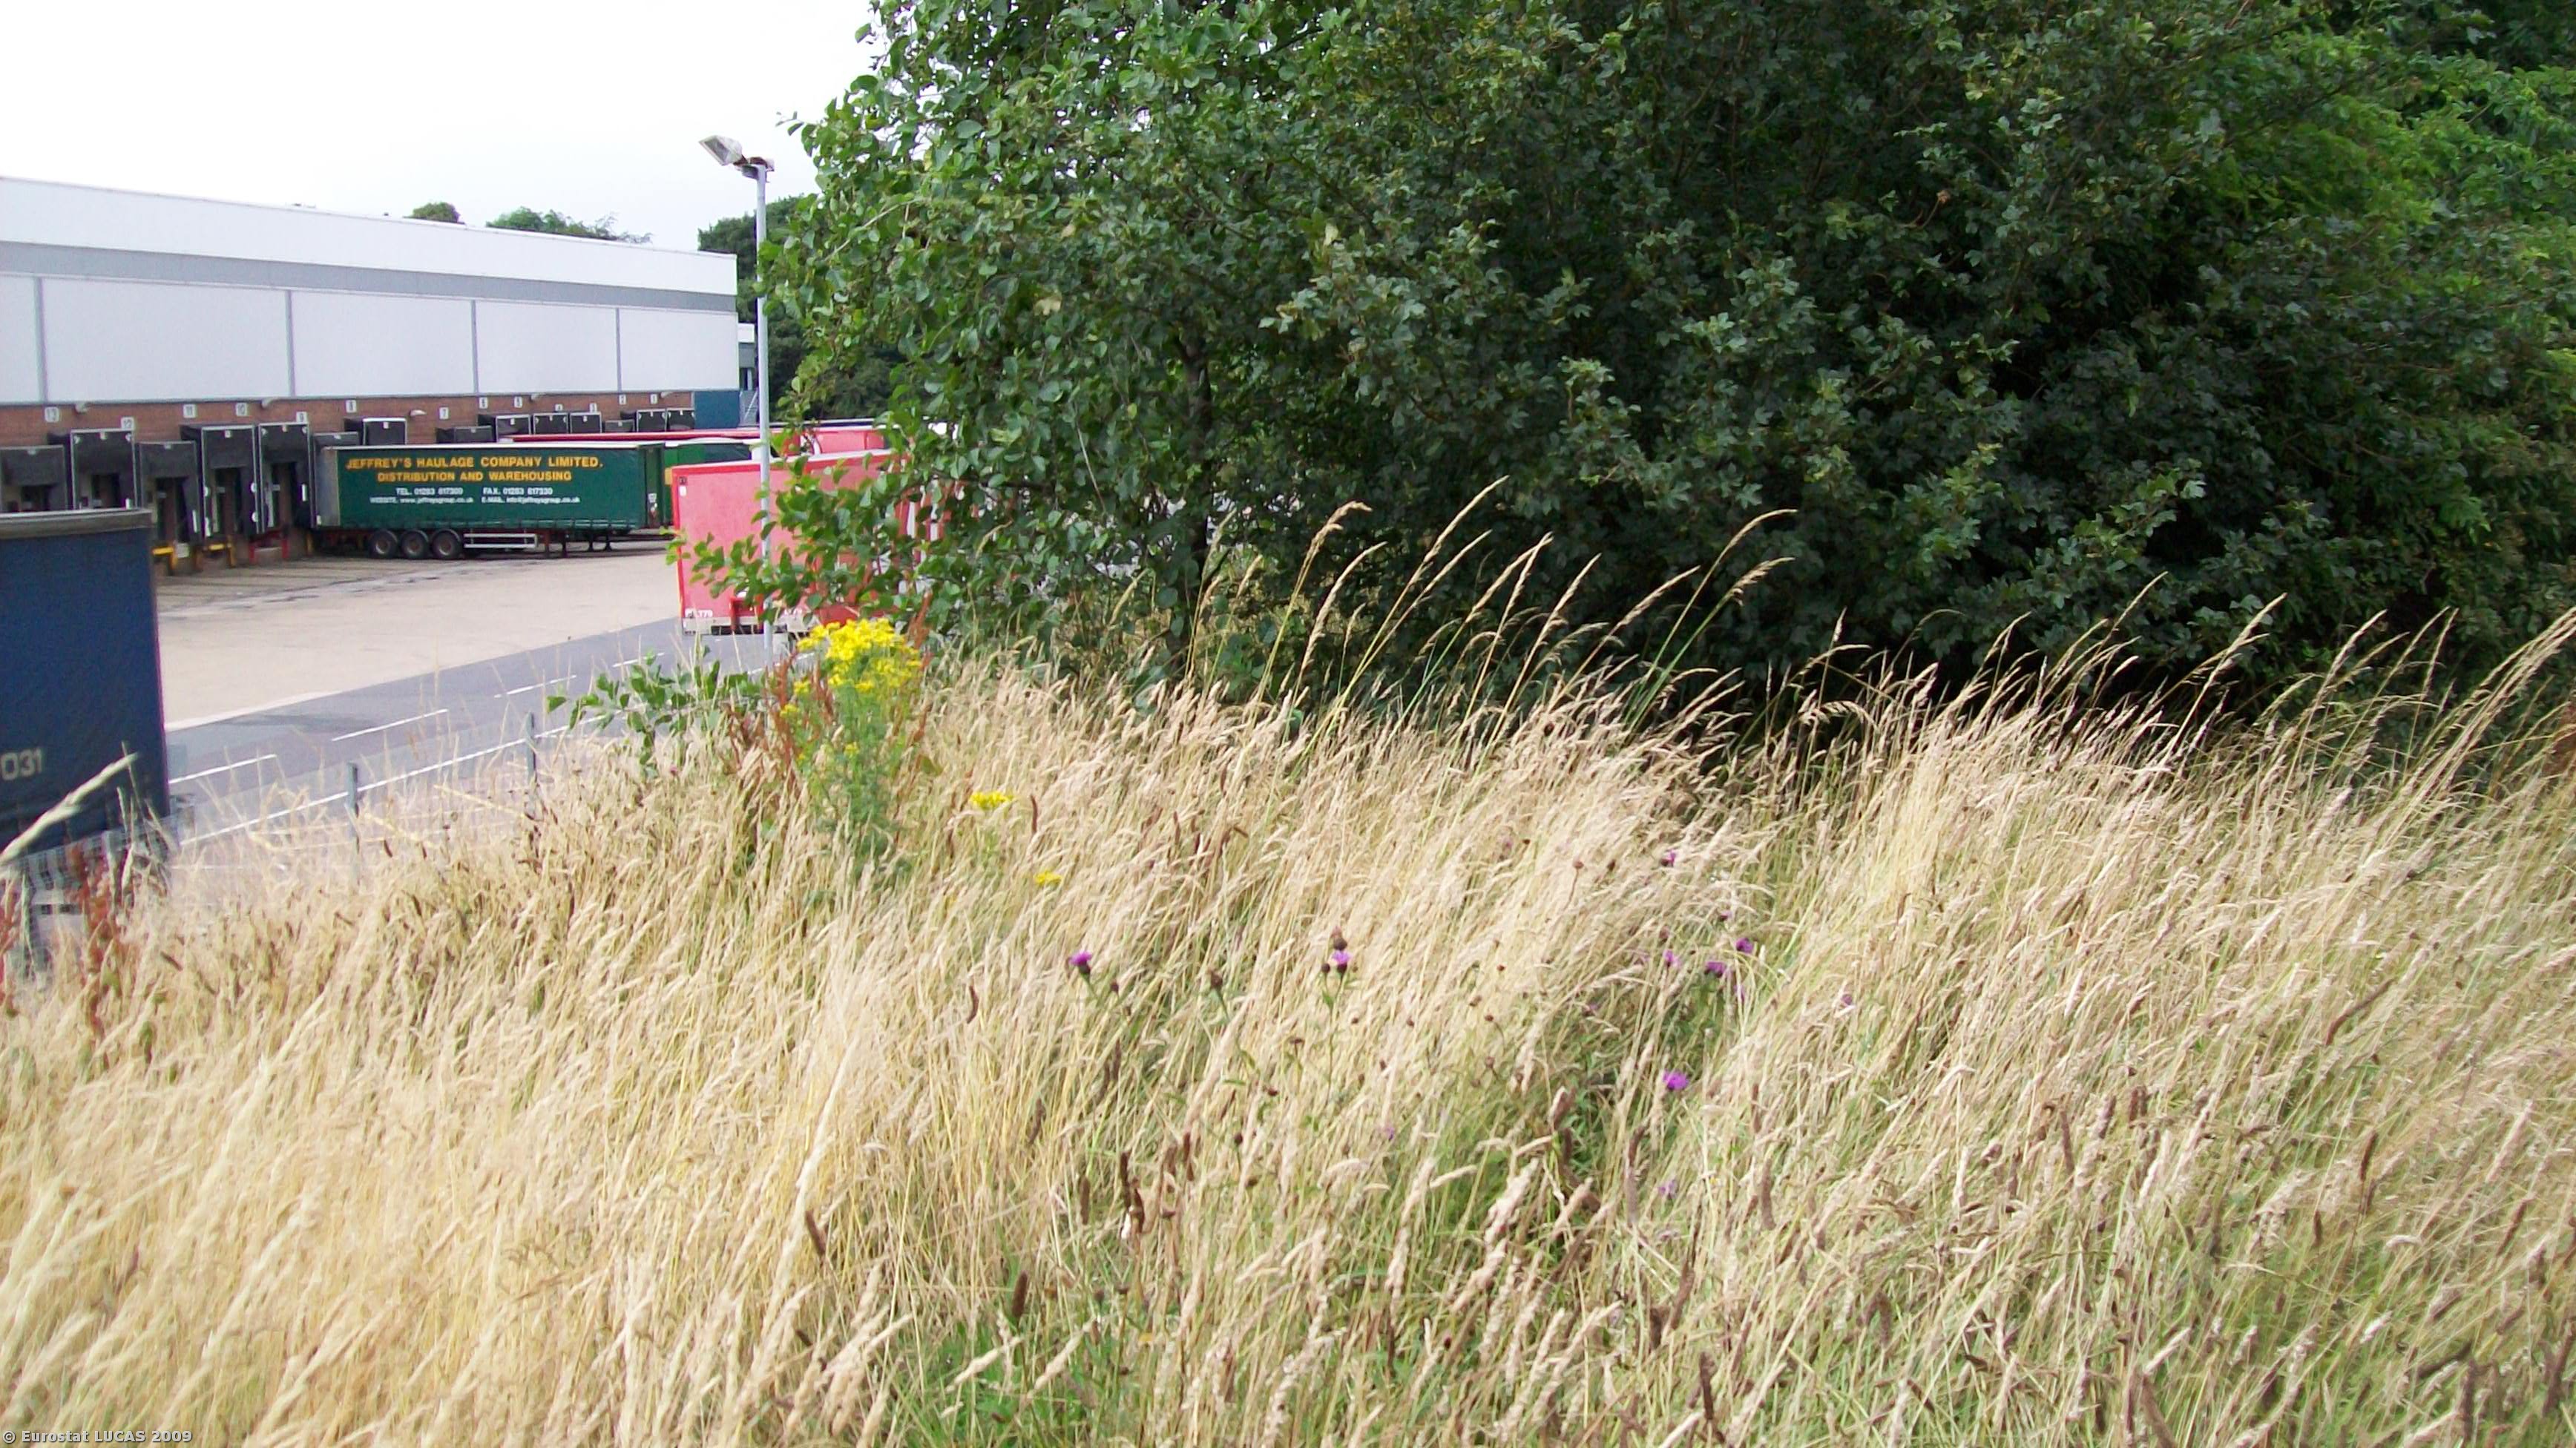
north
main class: Grassland
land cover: Grassland with sparse tree/shrub cover
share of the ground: > 75 %
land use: Unused
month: July
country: GB
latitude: 52.7038
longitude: -1.3405
